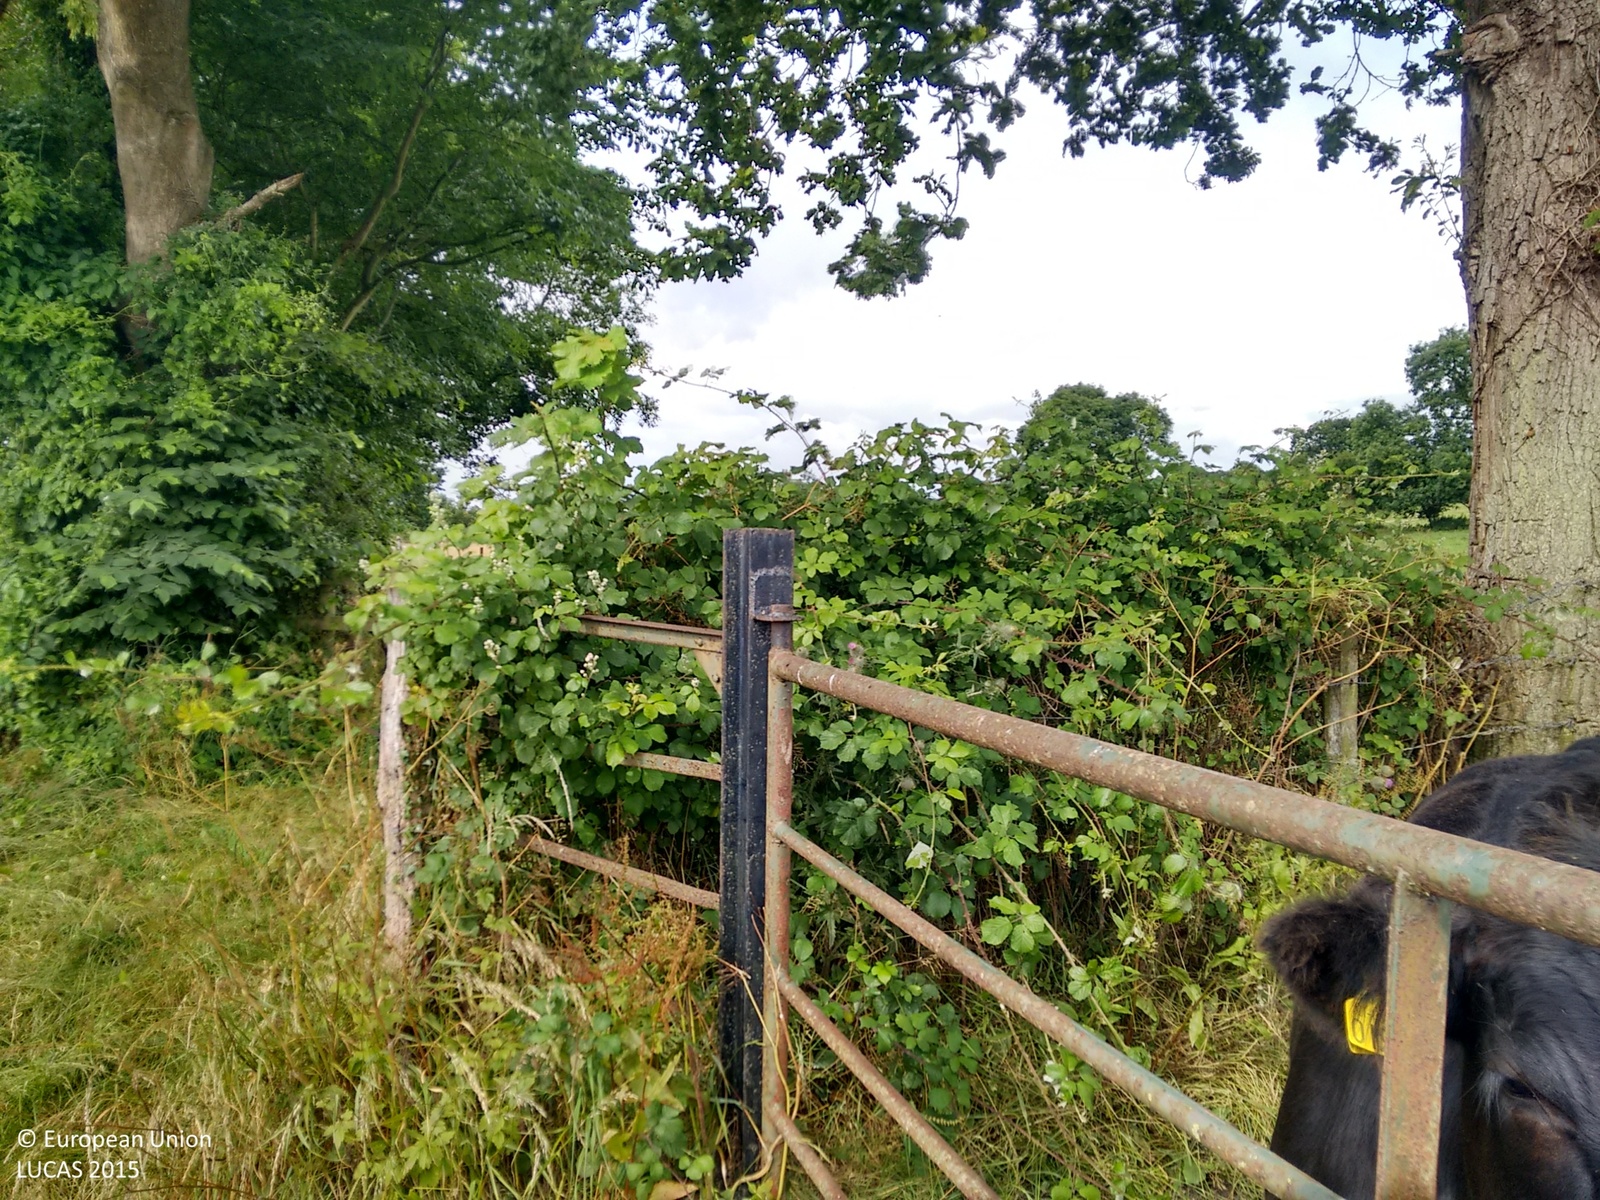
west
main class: Grassland
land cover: Grassland without tree/shrub cover
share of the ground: > 75 %
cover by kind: herbaceous plants 100 %
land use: Agriculture (excluding fallow land and kitchen gardens)
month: July
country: IE
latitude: 52.6082
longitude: -7.3885
